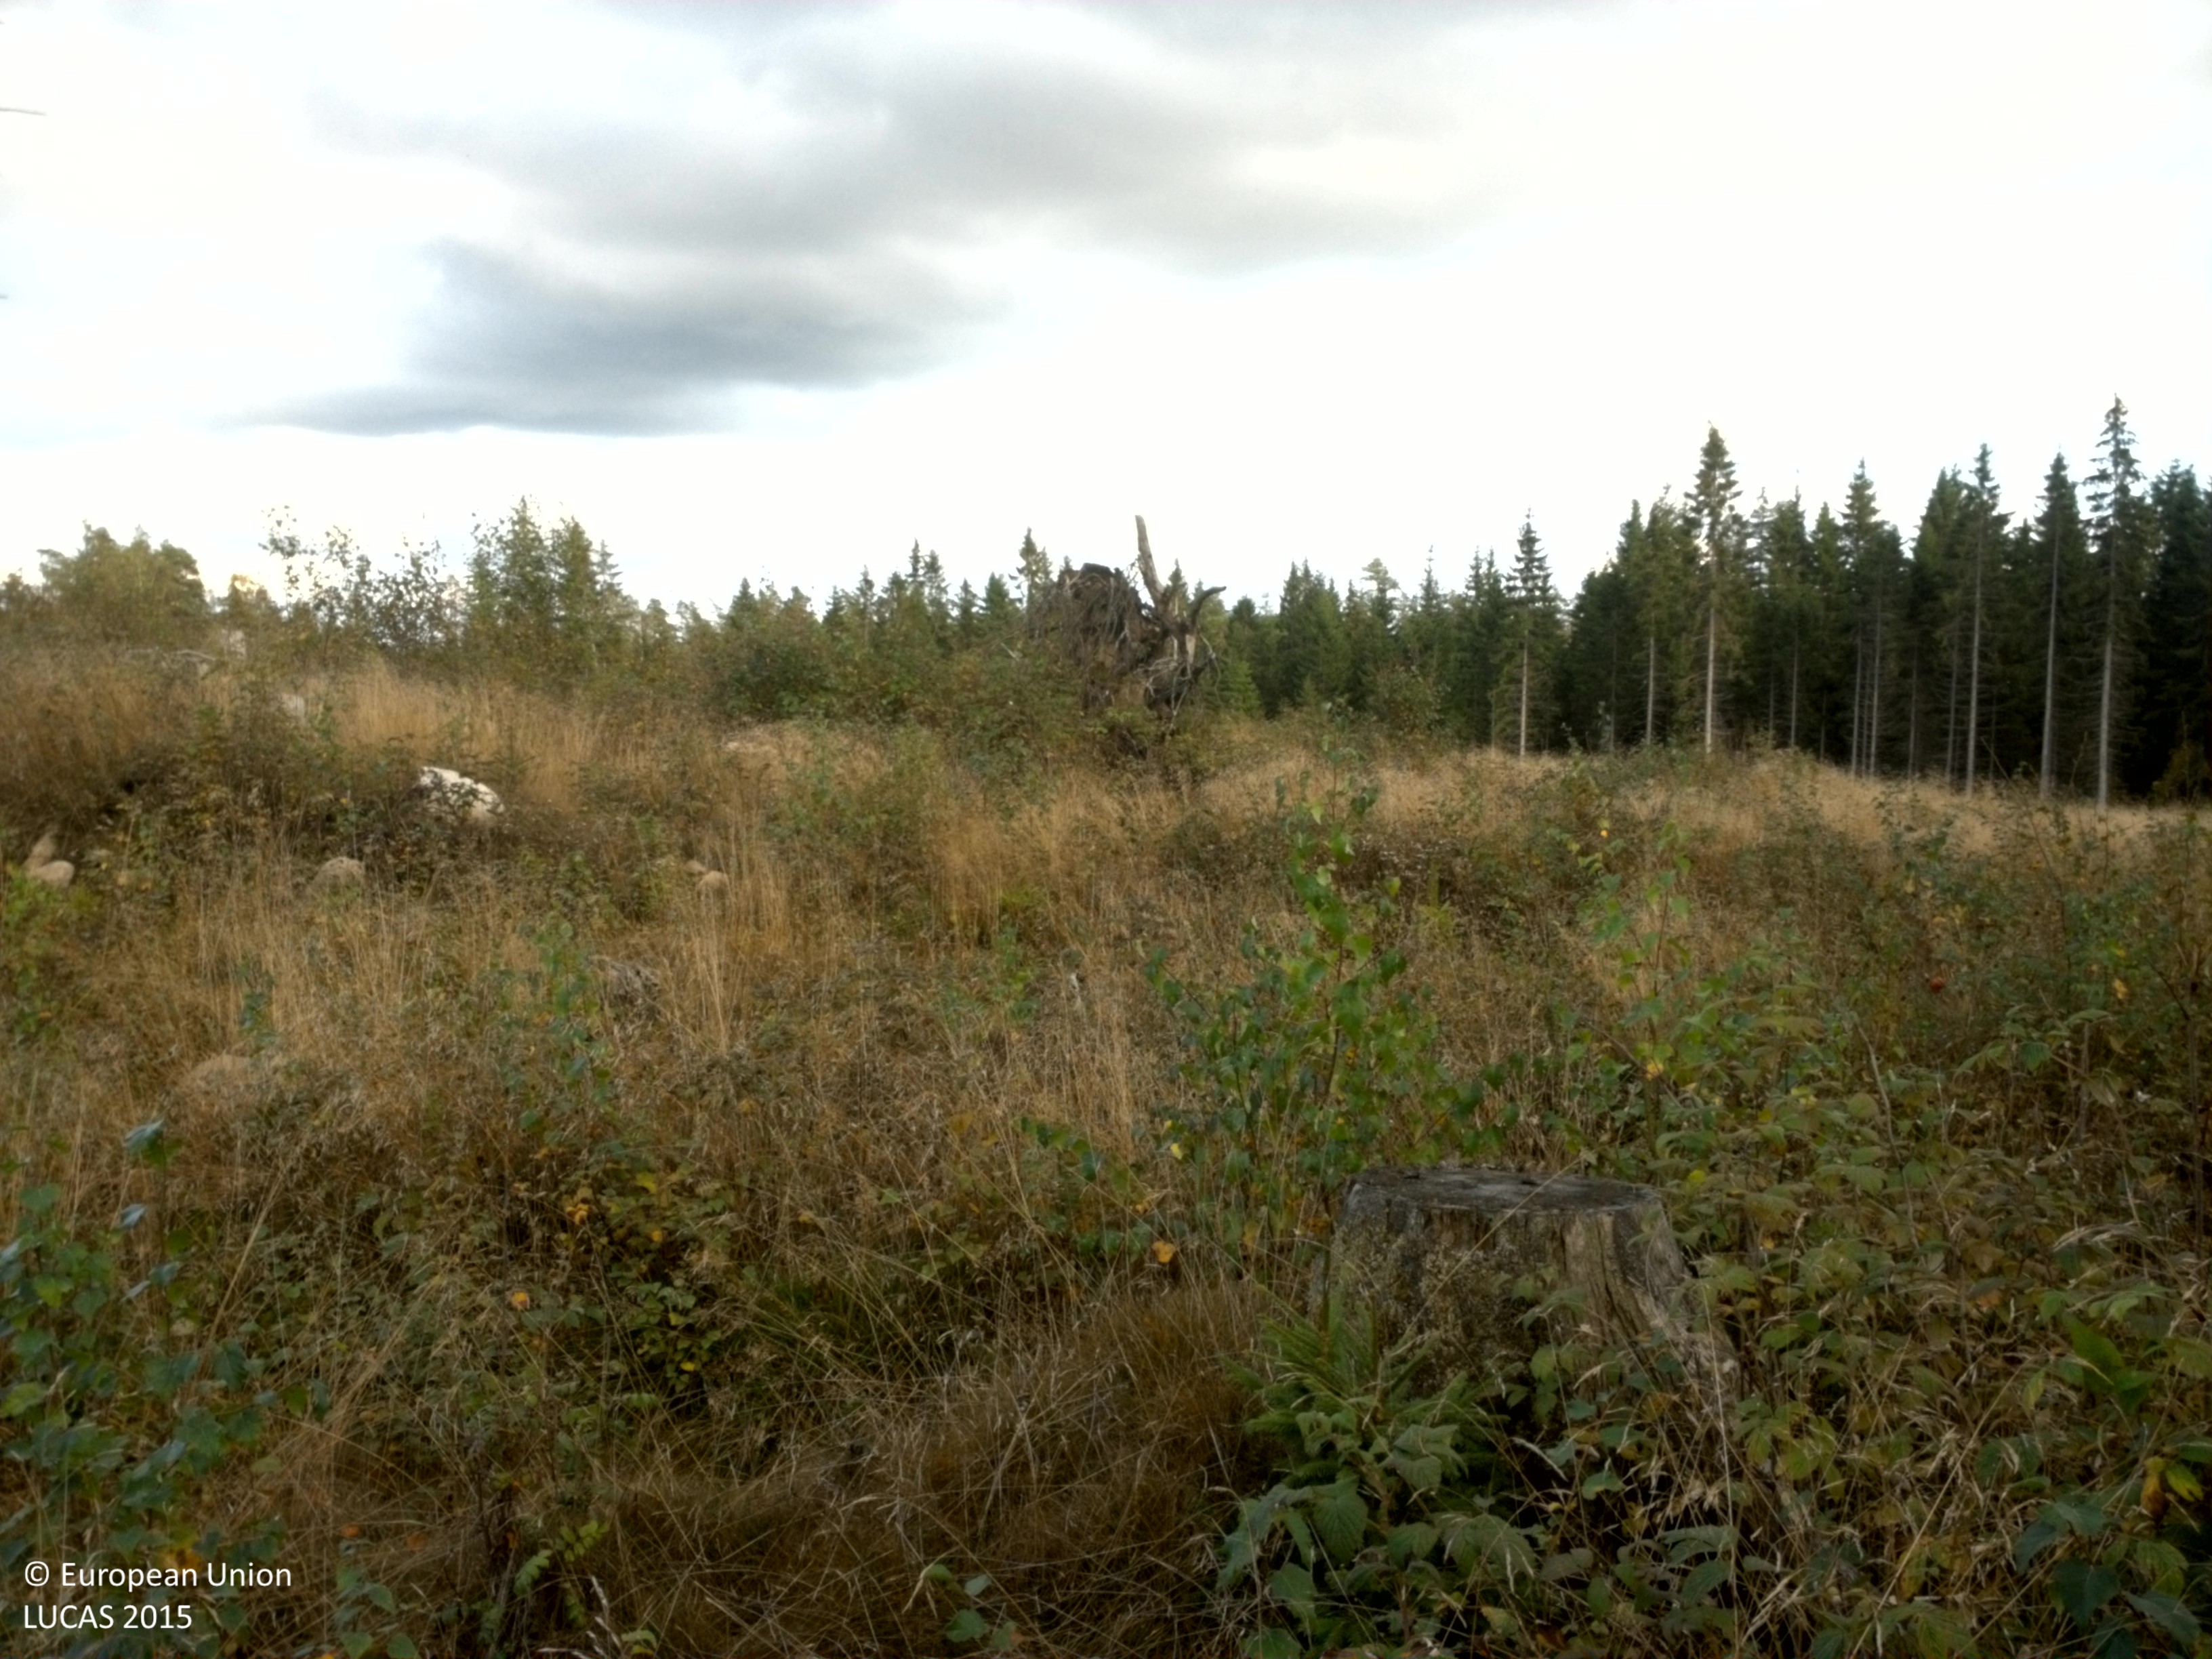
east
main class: Shrubland
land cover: Shrubland with sparse tree cover
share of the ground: 50 - 75 %
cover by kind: herbaceous plants 50 %, shrubs 45 %, broadleaved forest trees 5 %
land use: Forestry
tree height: < 5 m
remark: Clear cut
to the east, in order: Shrubland with sparse tree cover; Broadleaved woodland; Peatbogs; Spruce dominated mixed woodland
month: September
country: SE
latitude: 57.8775
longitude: 13.1146
